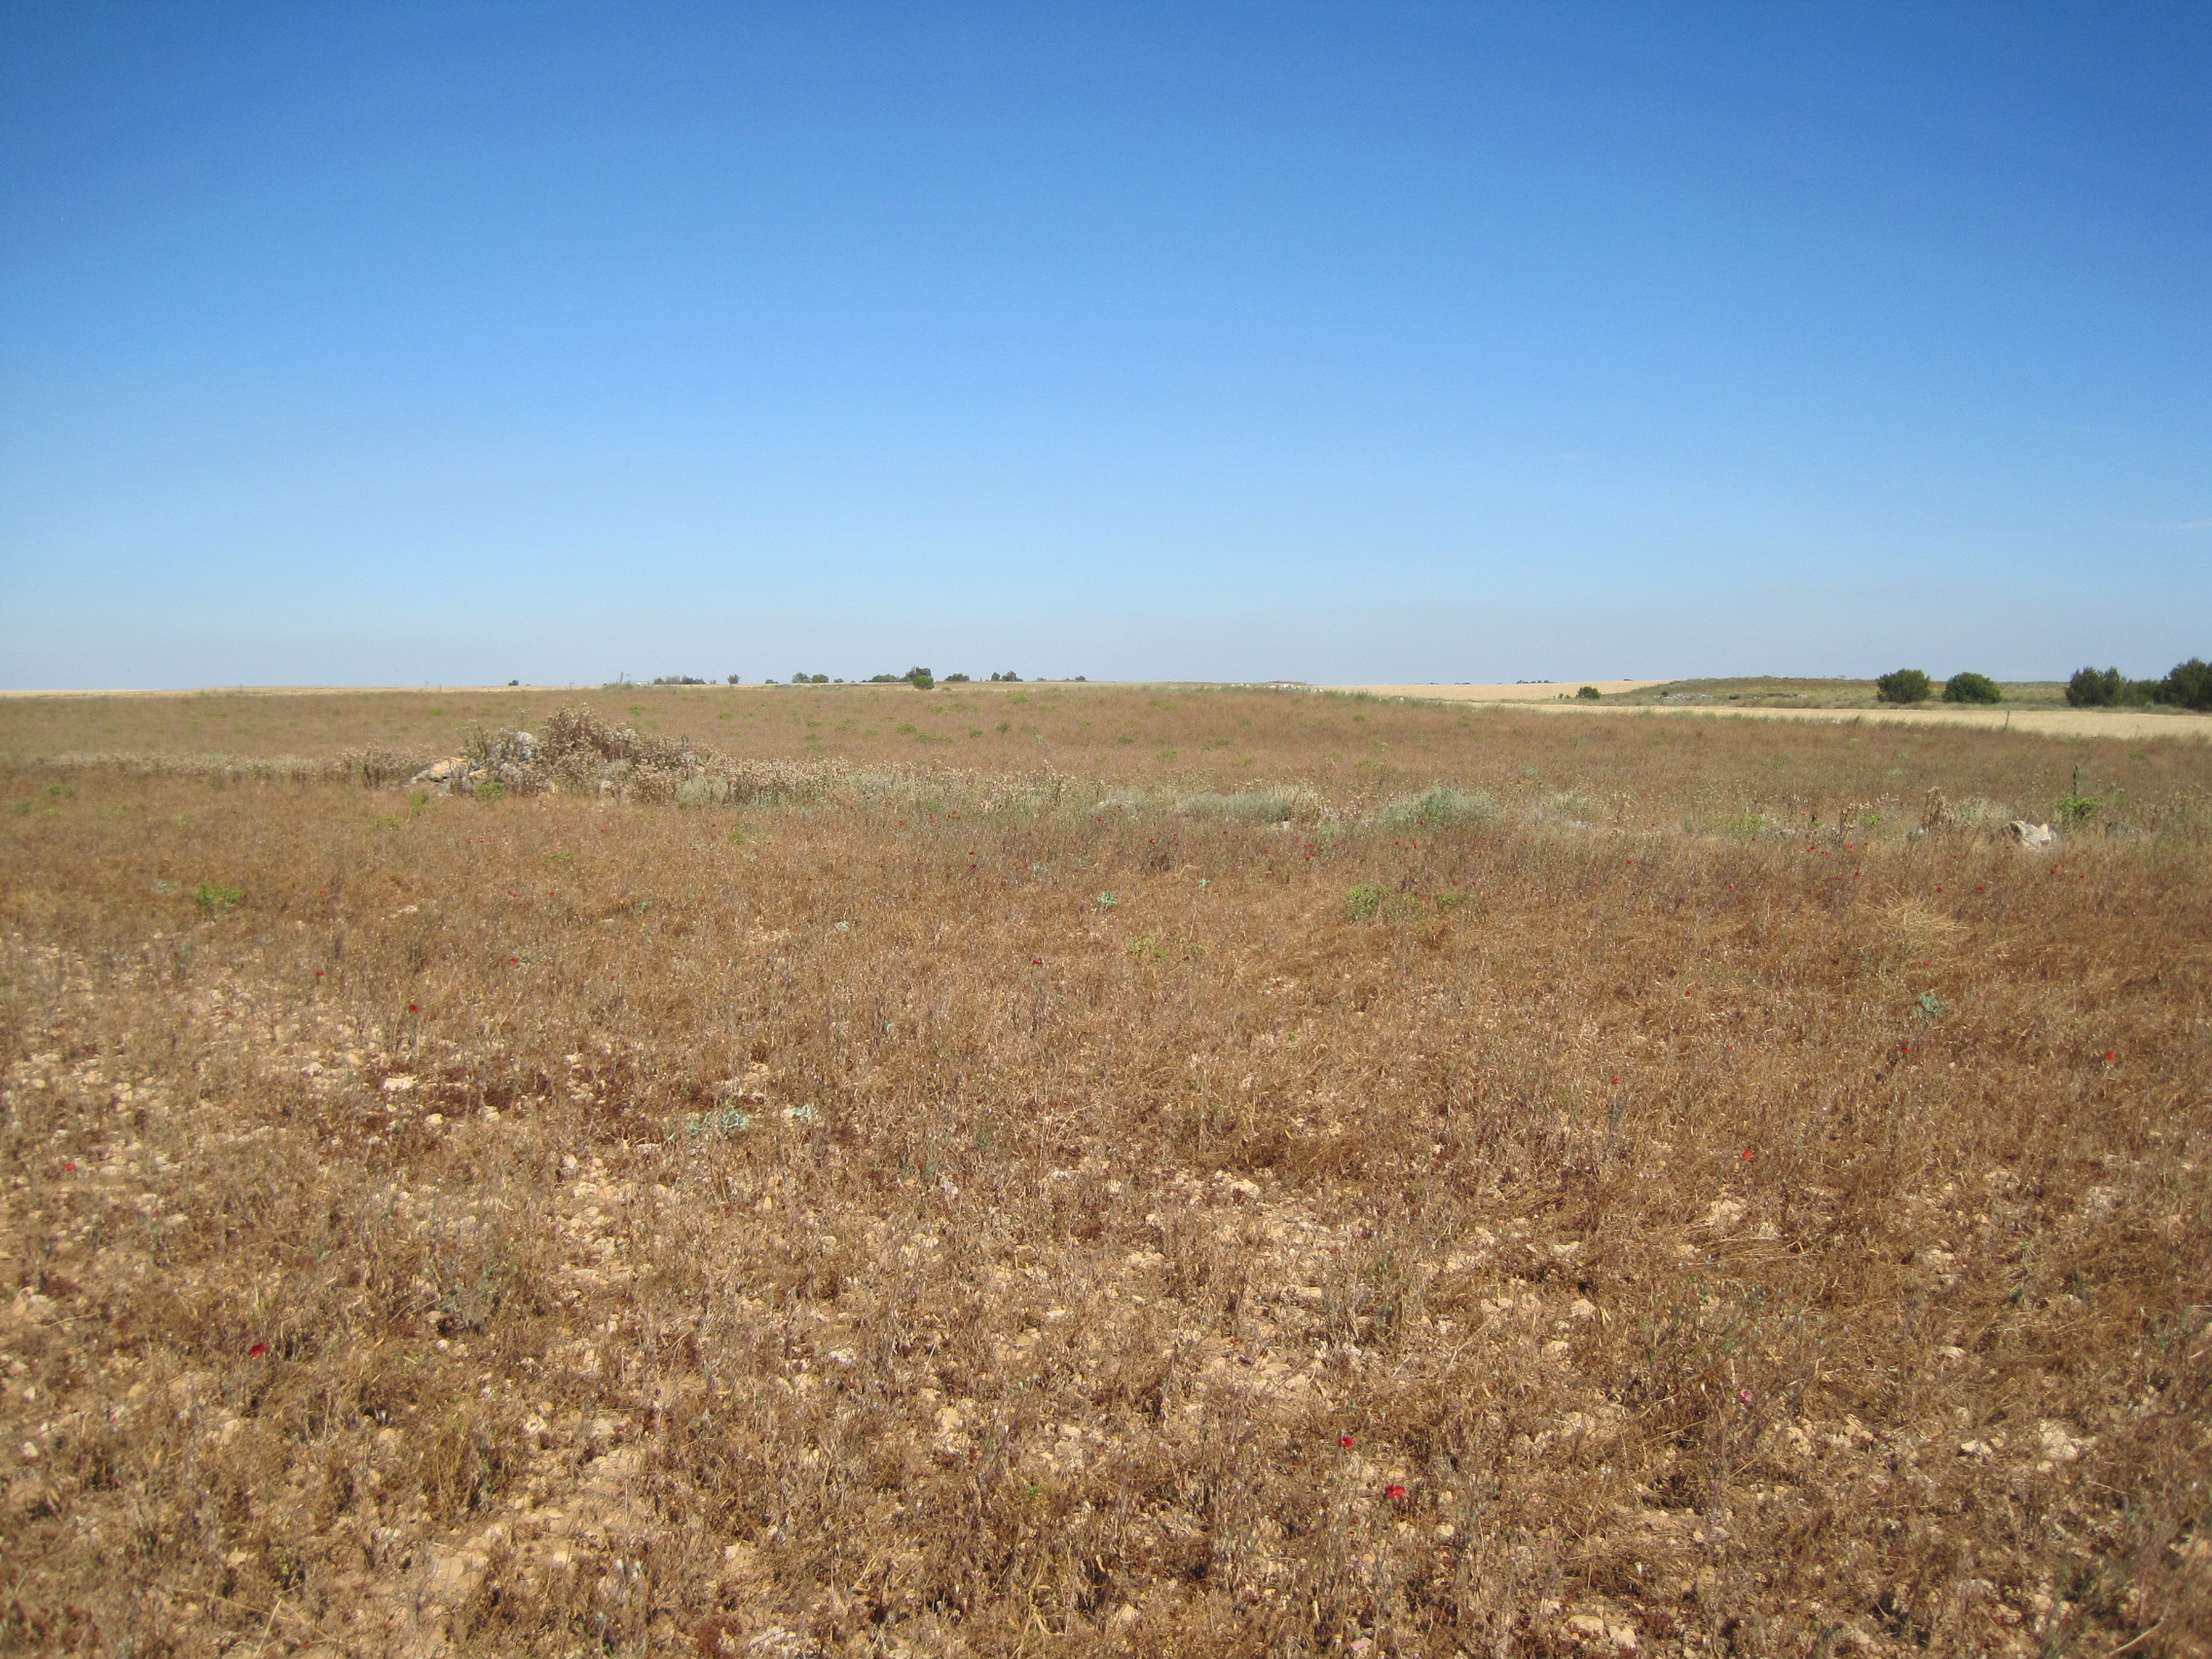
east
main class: Cropland
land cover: Dry pulses
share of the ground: > 75 %
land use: Agriculture (excluding fallow land and kitchen gardens)
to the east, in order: Dry pulses; Grass margins; Dry pulses; Grass margins; Barley; Grassland without tree/shrub cover; Barley
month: June
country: ES
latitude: 41.6540
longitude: -5.1468
